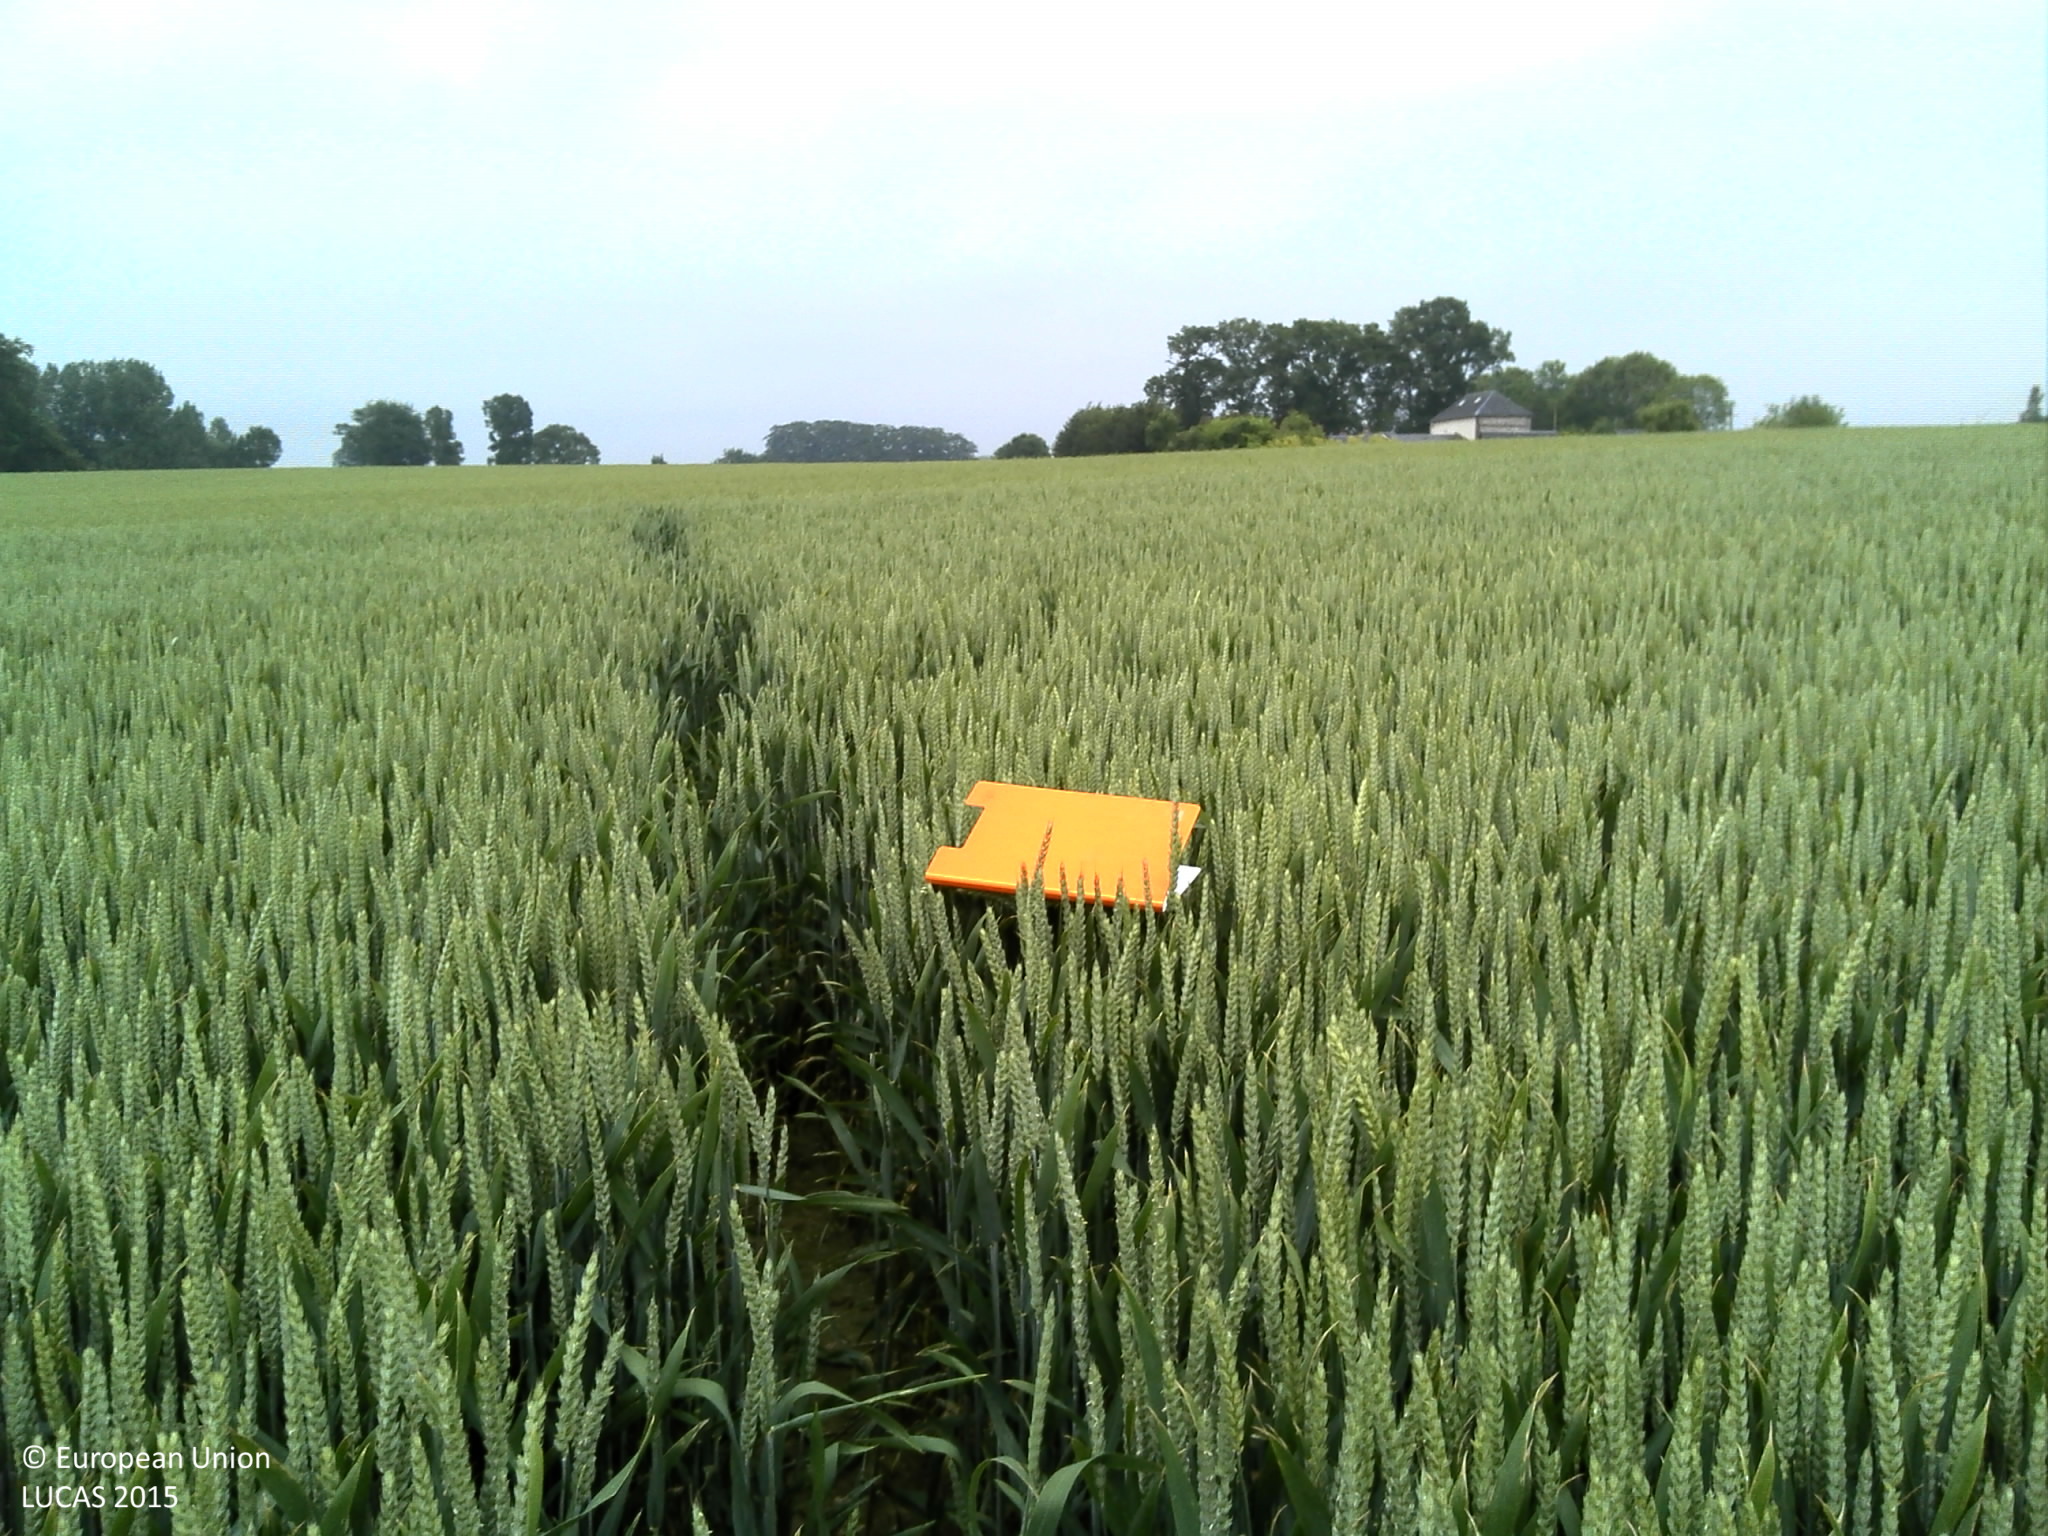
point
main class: Cropland
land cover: Common wheat
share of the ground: > 75 %
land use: Agriculture (excluding fallow land and kitchen gardens)
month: June
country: FR
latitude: 49.6493
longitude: 0.3737
